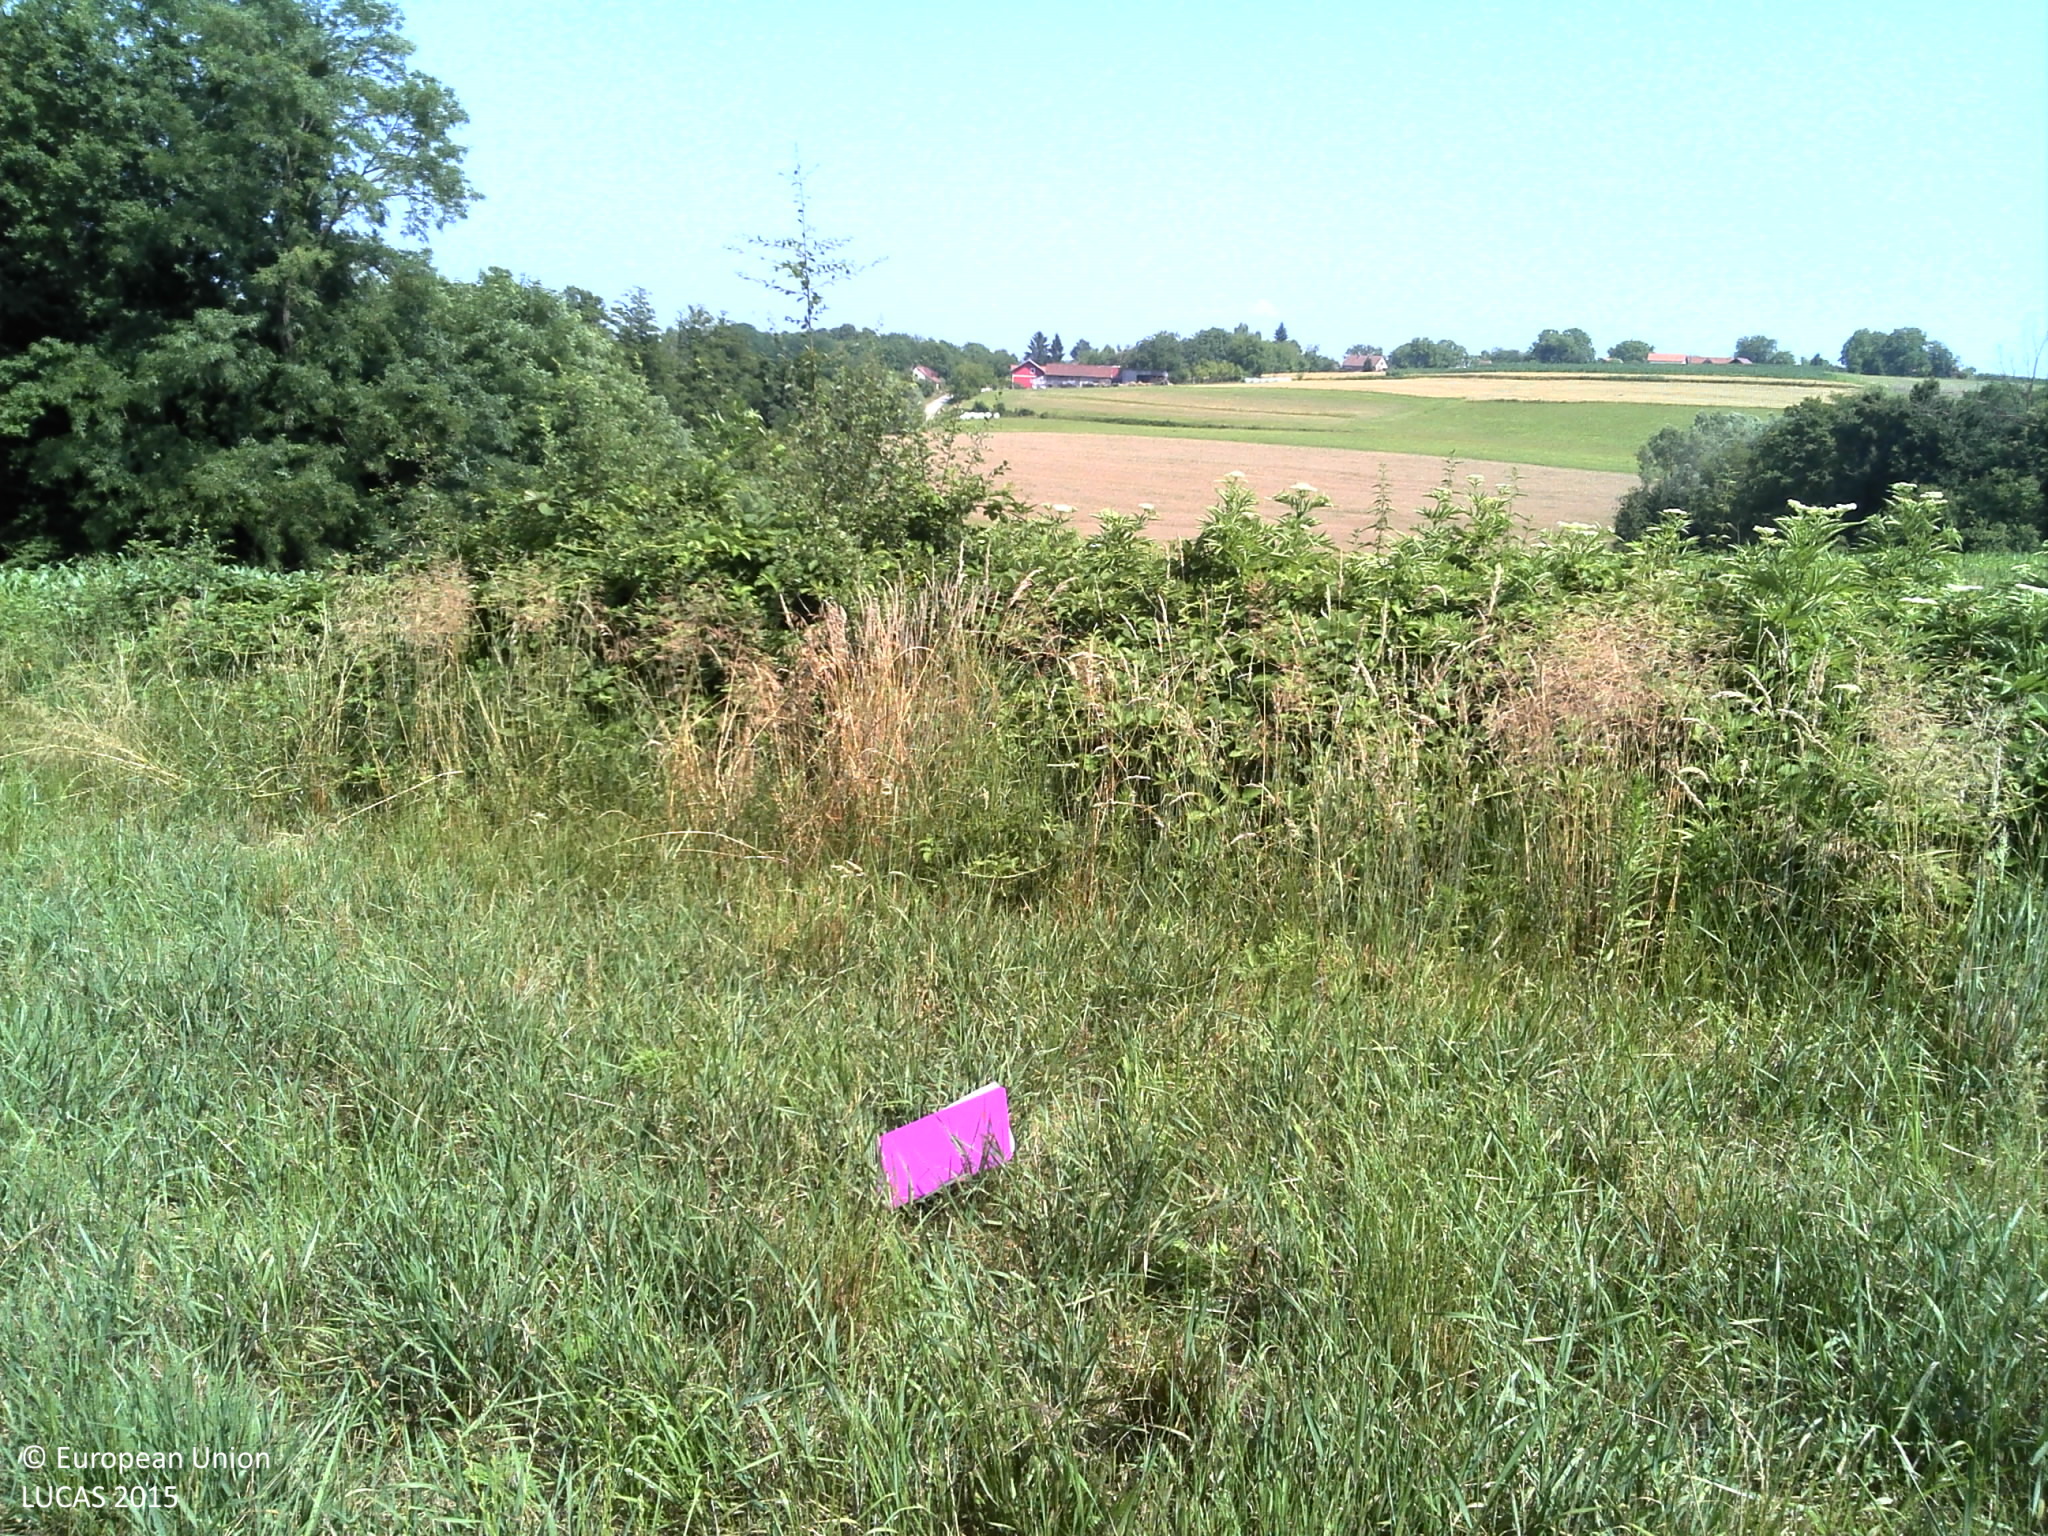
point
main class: Cropland
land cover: Temporary grasslands
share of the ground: > 75 %
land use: Agriculture (excluding fallow land and kitchen gardens)
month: July
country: HR
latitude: 45.7893
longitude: 16.8307
